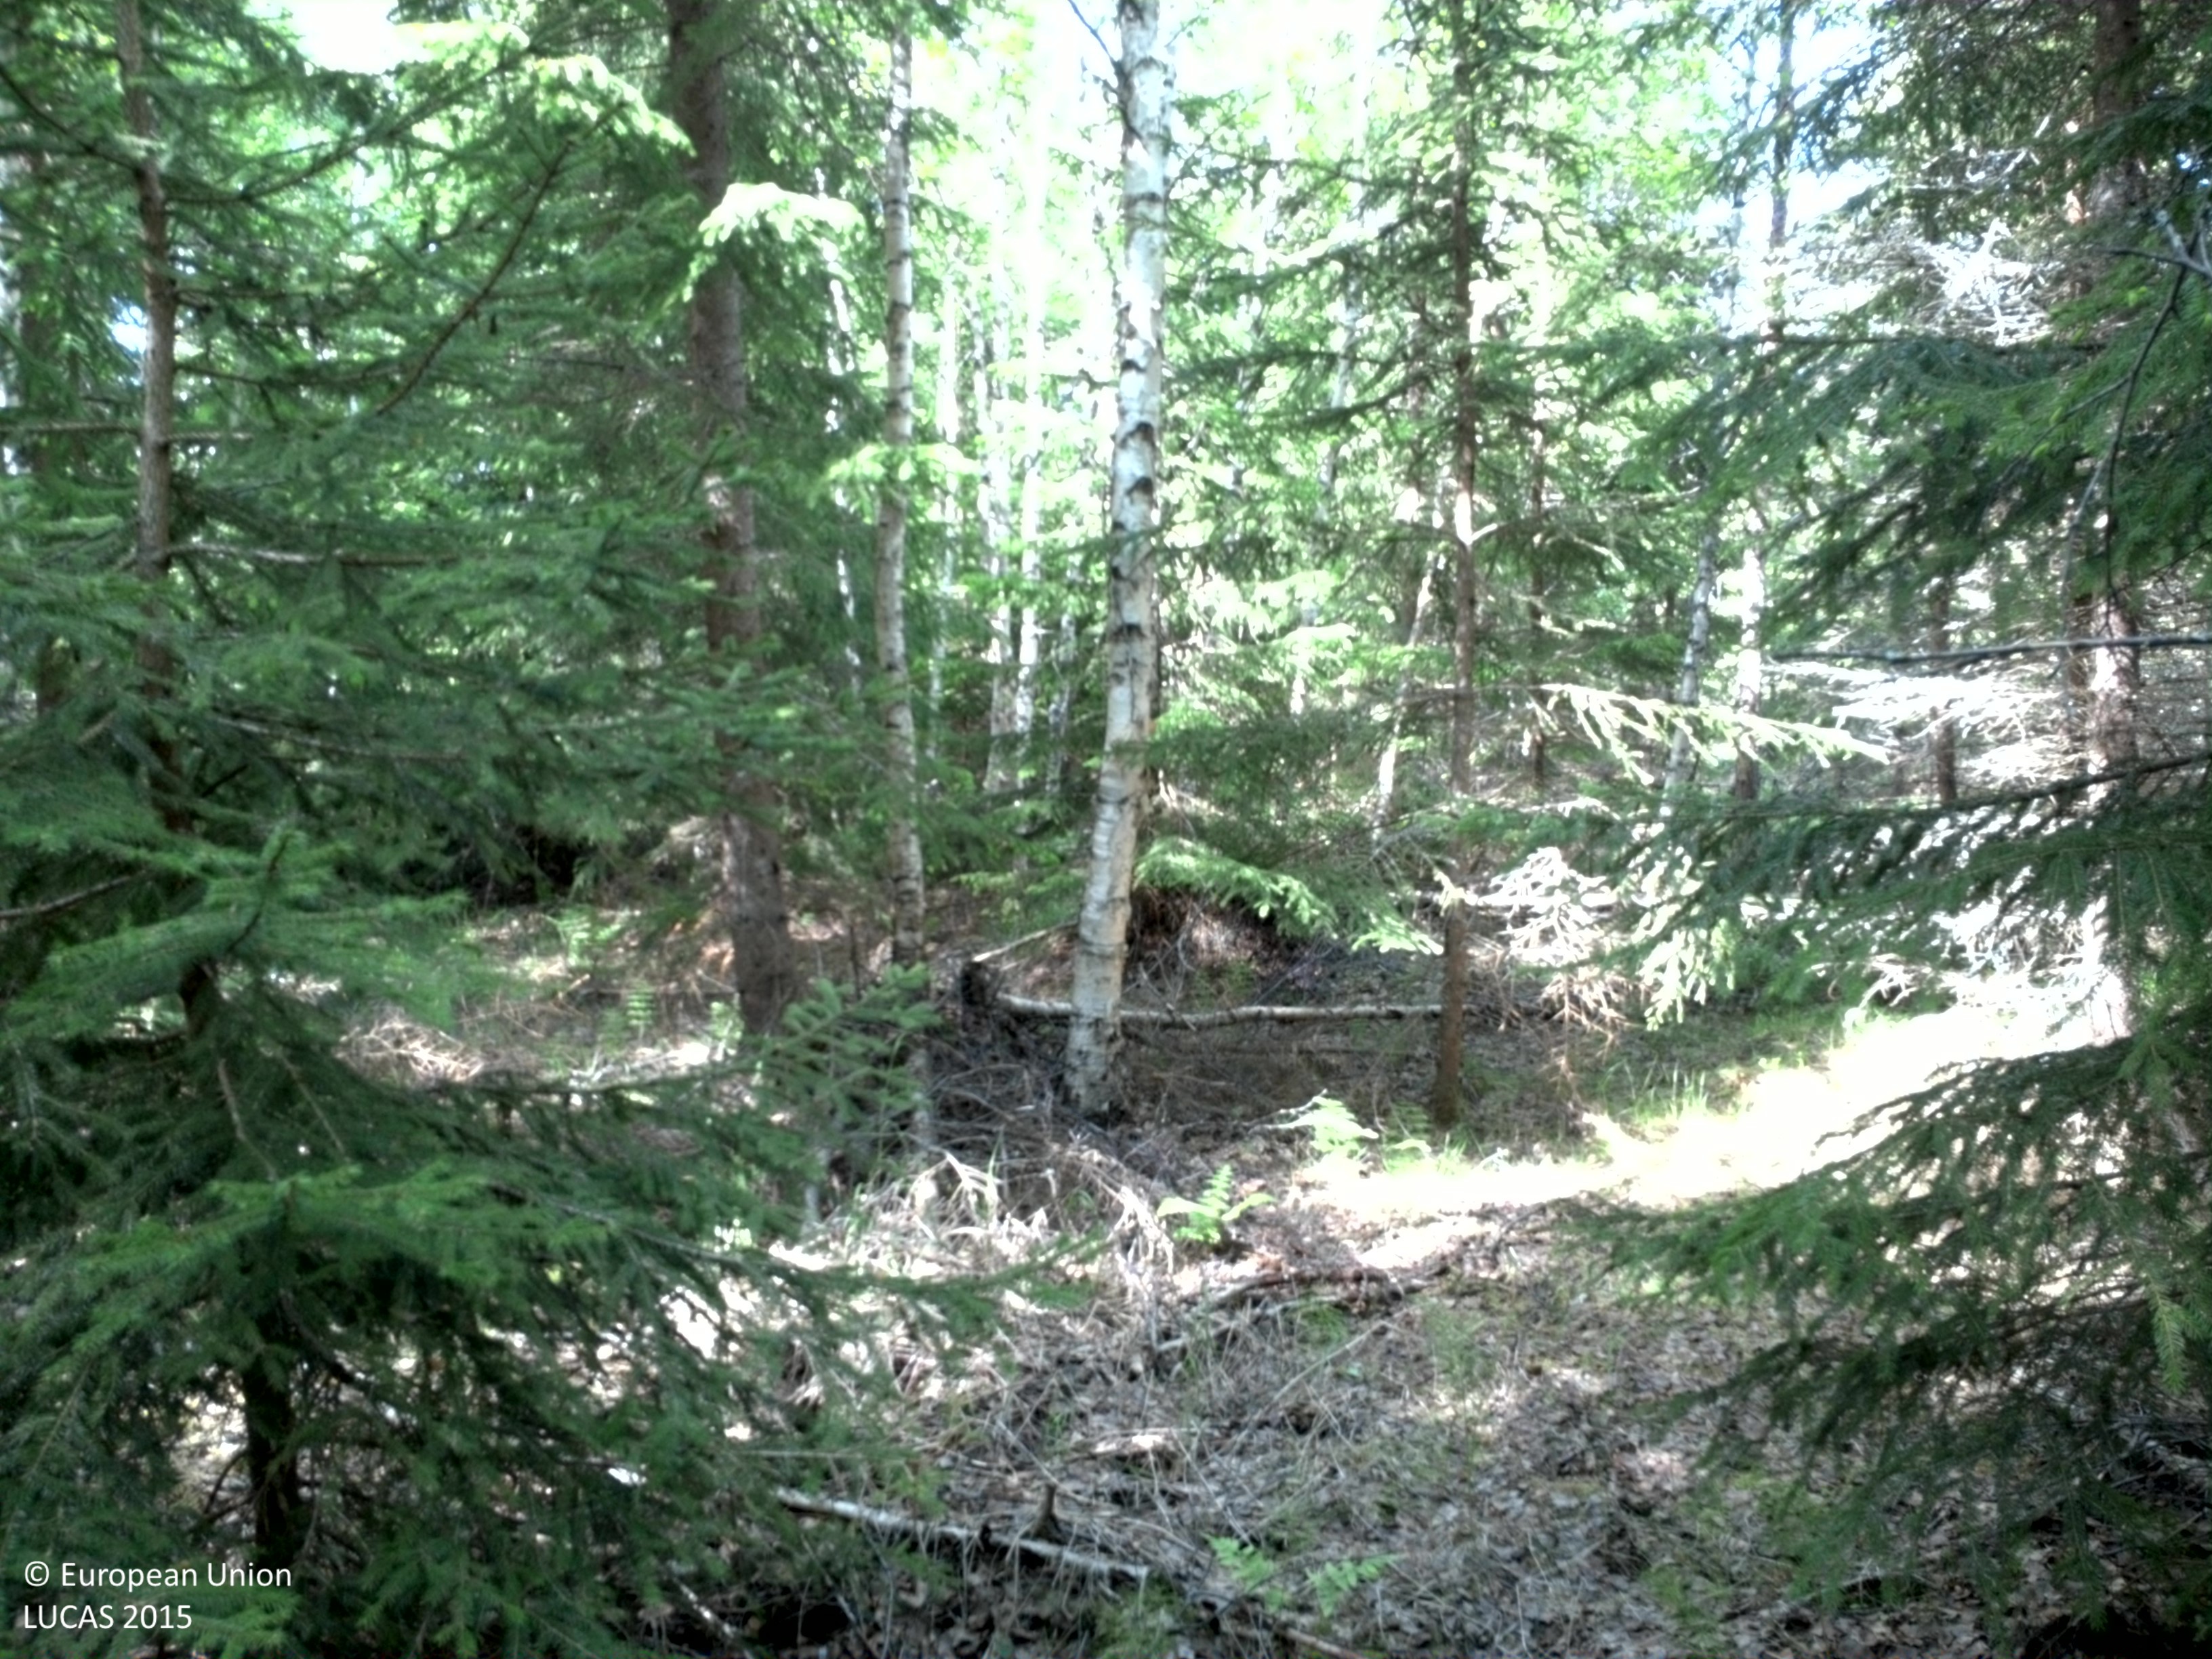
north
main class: Woodland
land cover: Spruce dominated mixed woodland
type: hemiboreal forest and nemoral coniferous forest and mixed broadleaved-coniferous forest
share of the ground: > 75 %
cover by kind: coniferous forest trees 50 %, broadleaved forest trees 30 %, lichens and mosses 20 %
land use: Forestry
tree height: > 5 m
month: June
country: SE
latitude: 60.2178
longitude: 17.1204
